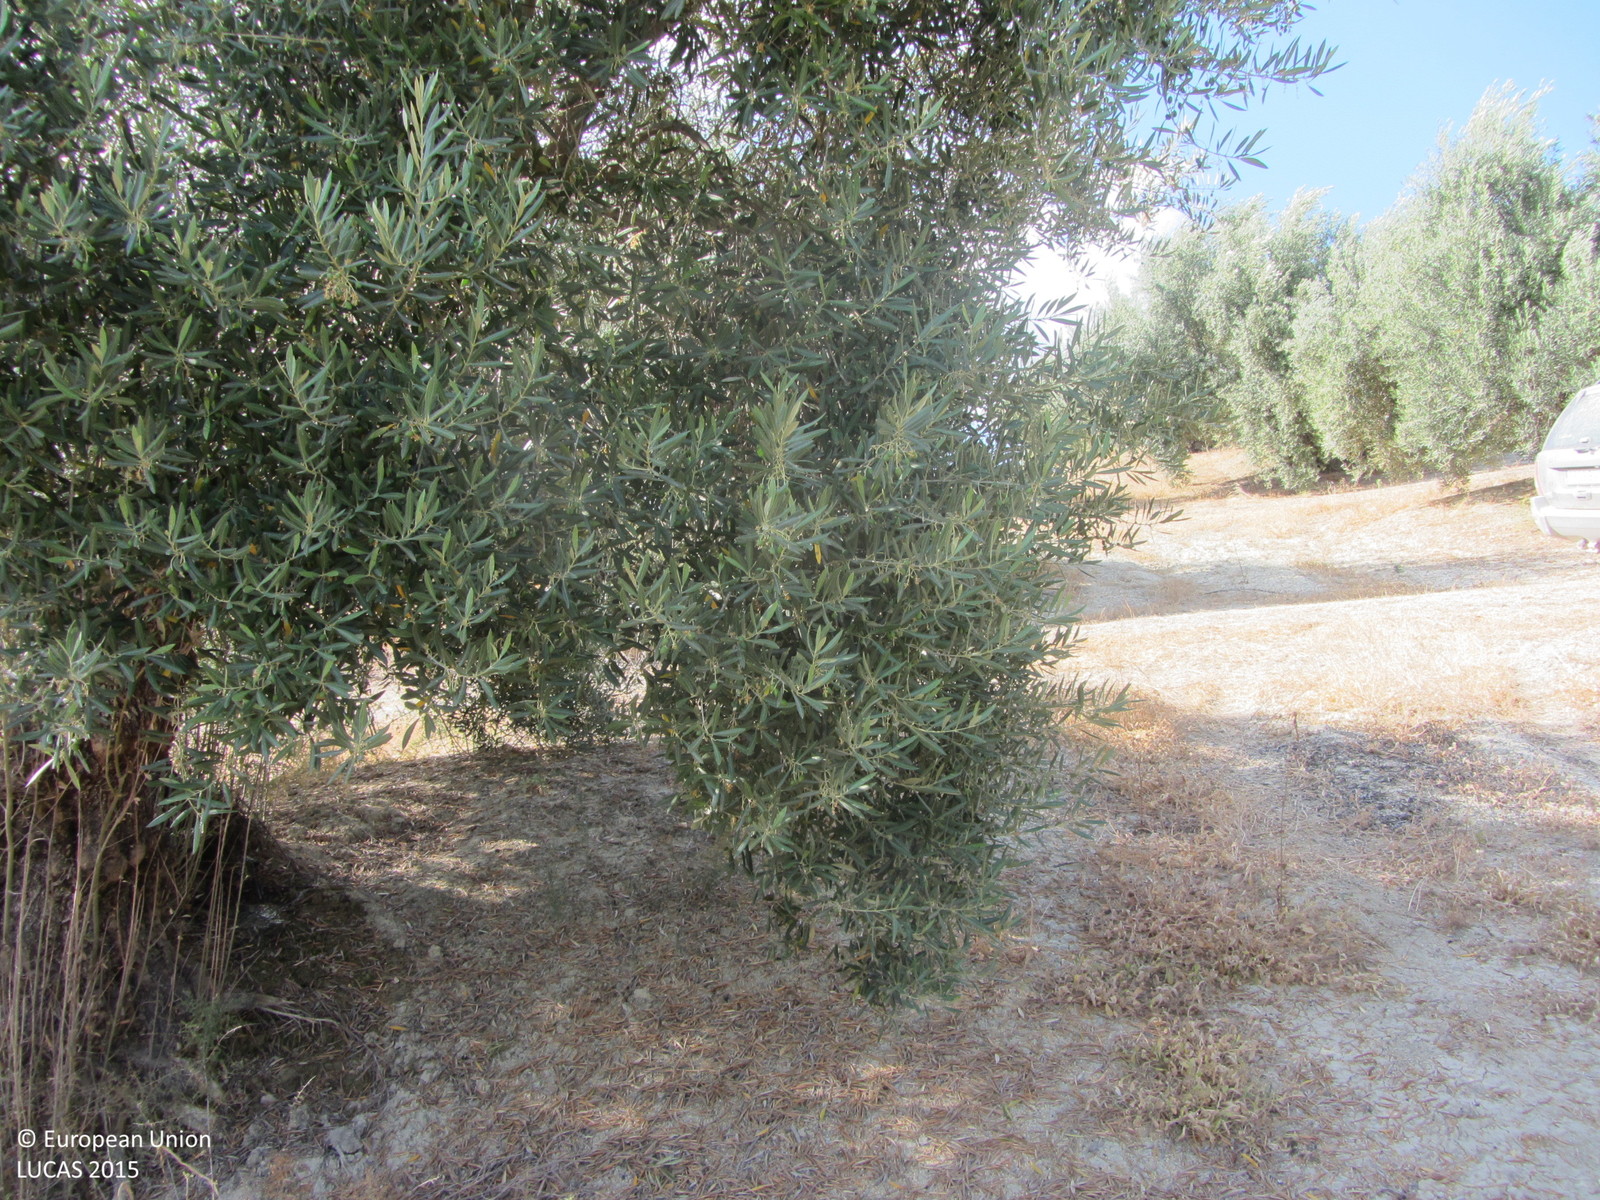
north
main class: Cropland
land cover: Olive groves
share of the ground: 50 - 75 %
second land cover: Other bare soil
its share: > 75 %
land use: Agriculture (excluding fallow land and kitchen gardens)
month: June
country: ES
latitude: 37.9703
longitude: -3.2599
